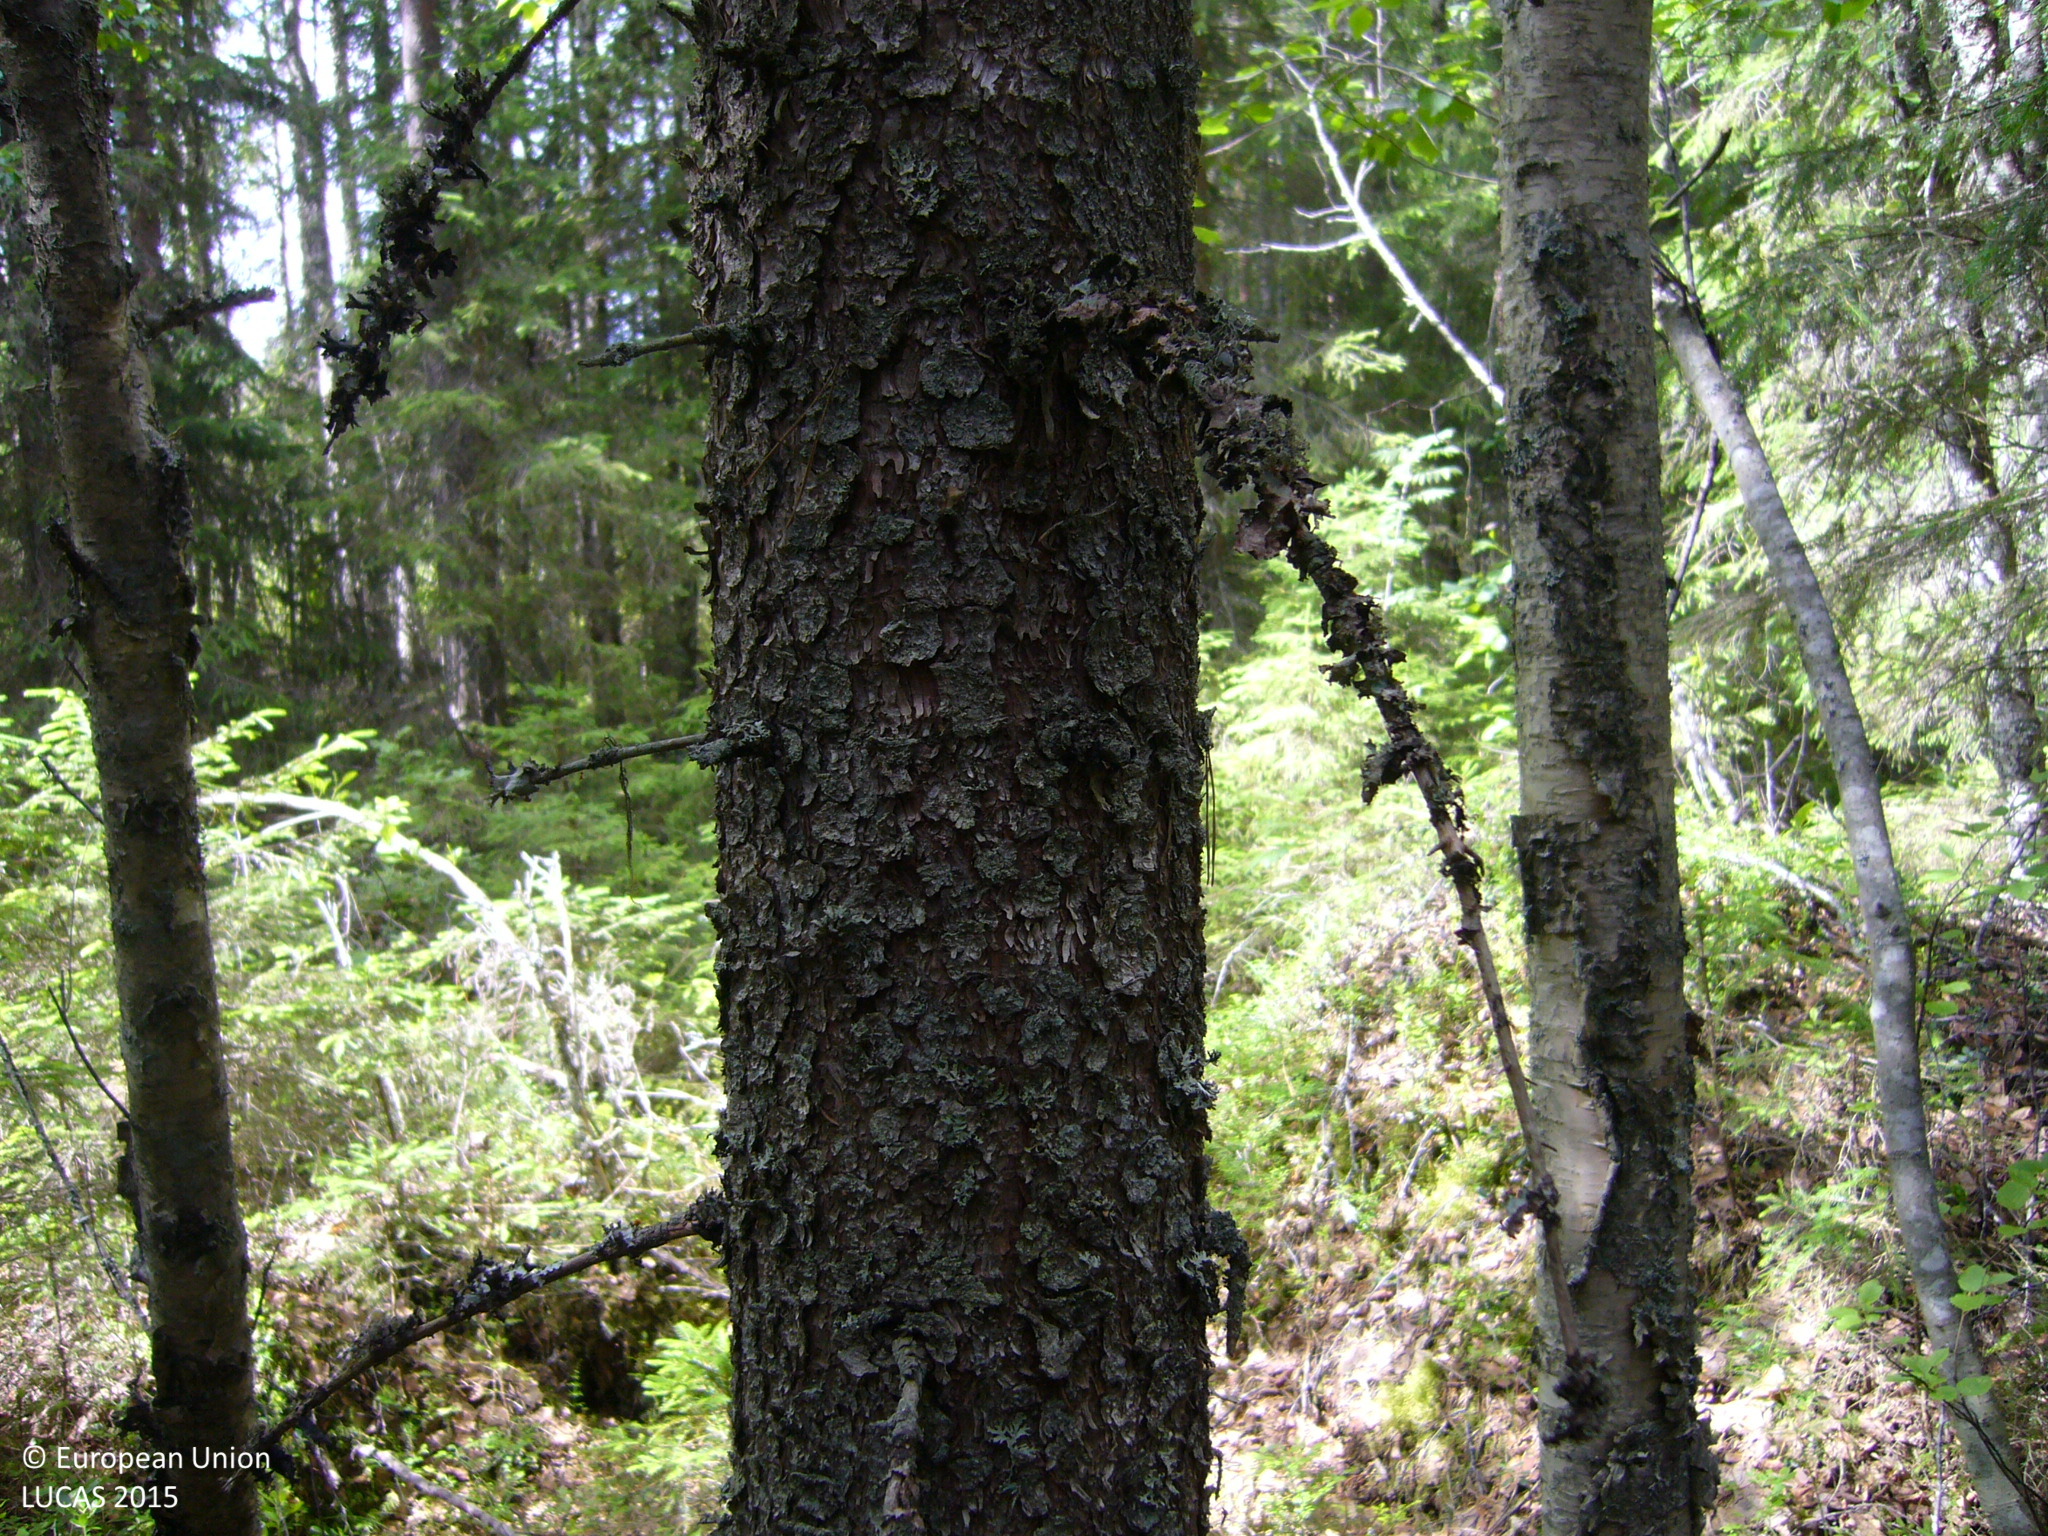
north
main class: Woodland
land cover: Spruce dominated mixed woodland
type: boreal forest
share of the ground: > 75 %
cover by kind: coniferous forest trees 60 %, broadleaved forest trees 30 %, shrubs 10 %
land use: Forestry
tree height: > 5 m
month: July
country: FI
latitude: 63.3144
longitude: 26.3920
